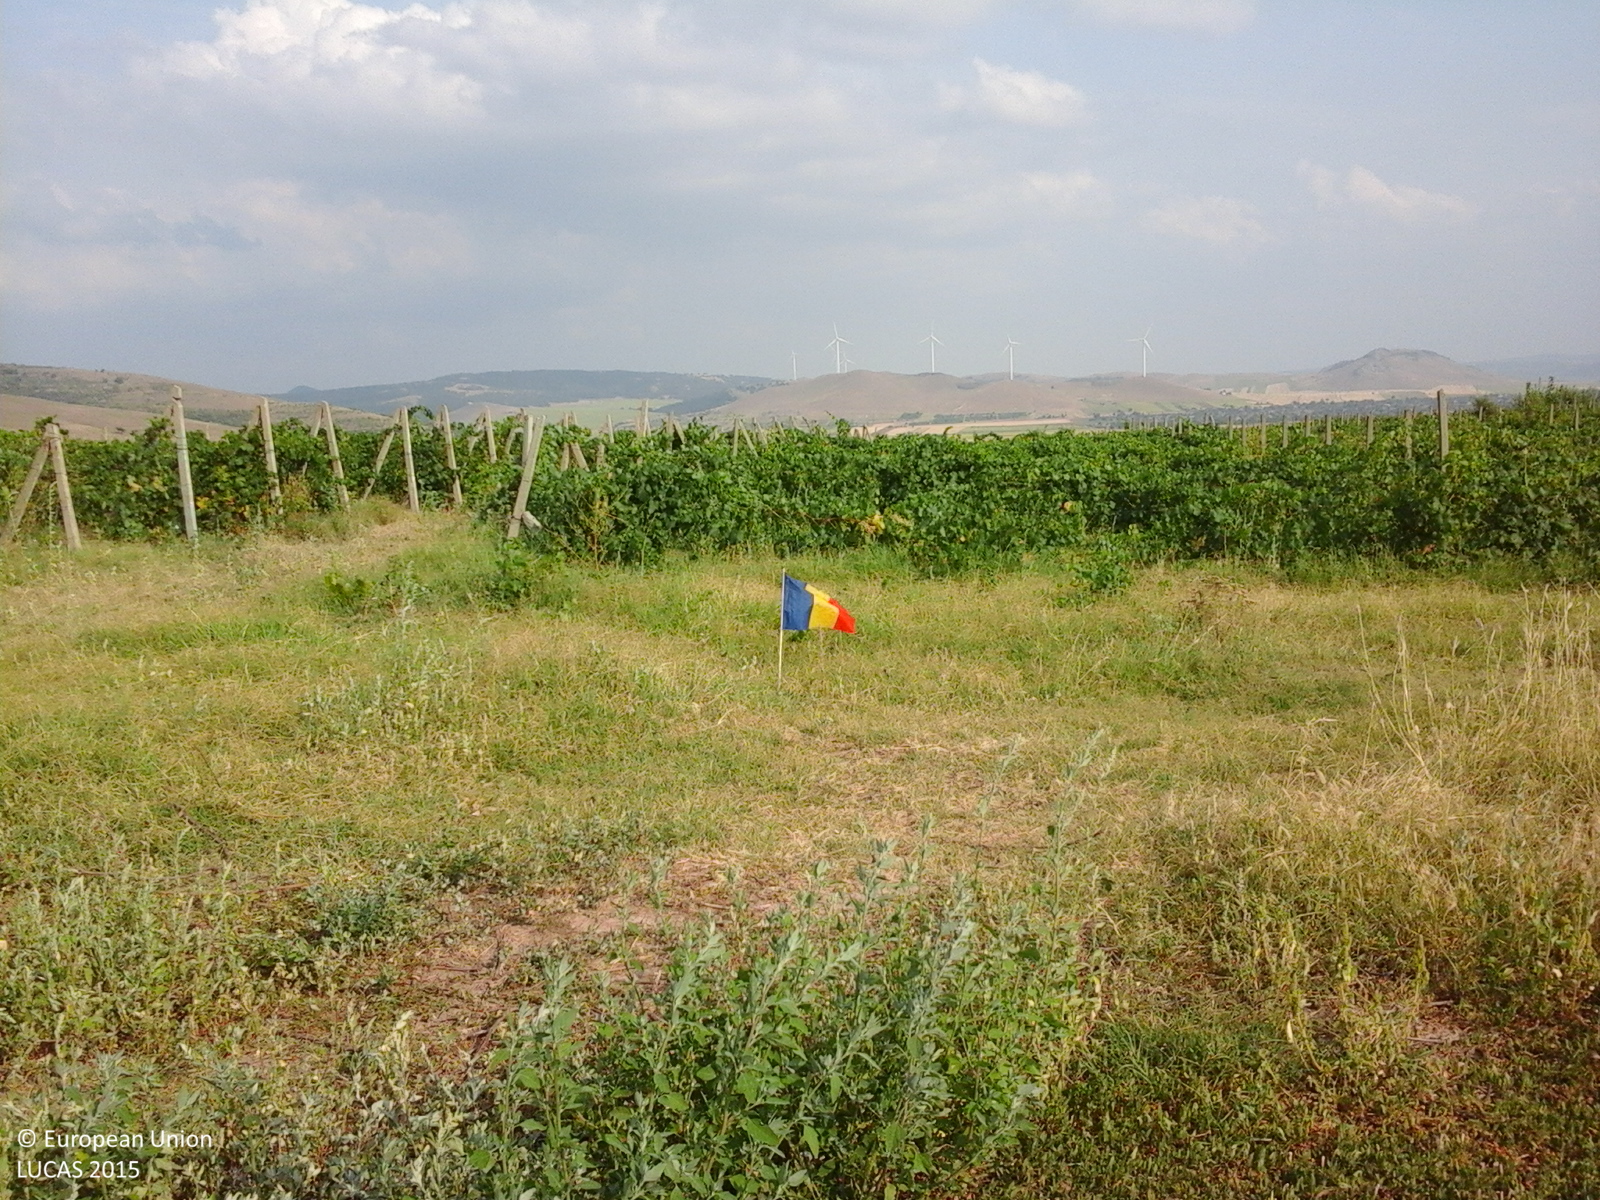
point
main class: Grassland
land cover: Grassland without tree/shrub cover
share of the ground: > 75 %
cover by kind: herbaceous plants 100 %
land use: Agriculture (excluding fallow land and kitchen gardens)
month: July
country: RO
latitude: 45.1080
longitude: 28.2852
